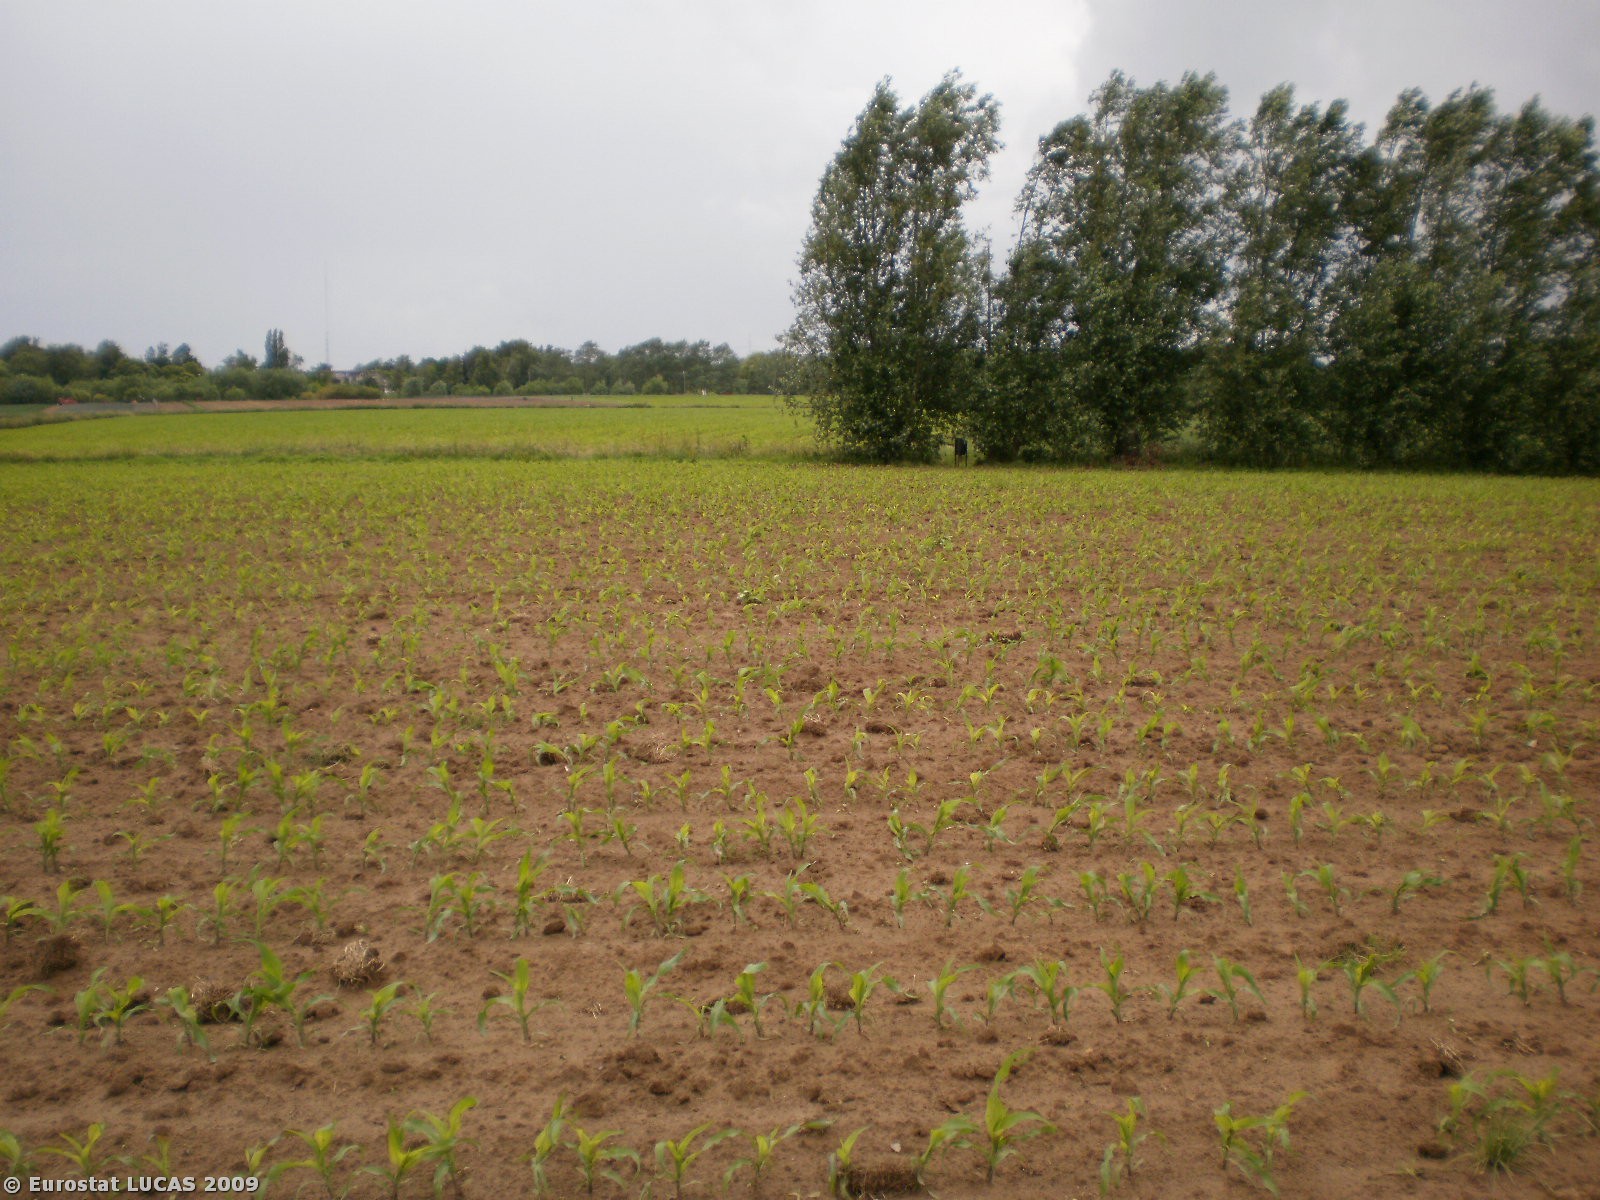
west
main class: Cropland
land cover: Maize
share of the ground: 10 - 25 %
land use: Agriculture (excluding fallow land and kitchen gardens)
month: June
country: BE
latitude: 51.0843
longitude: 4.2419
